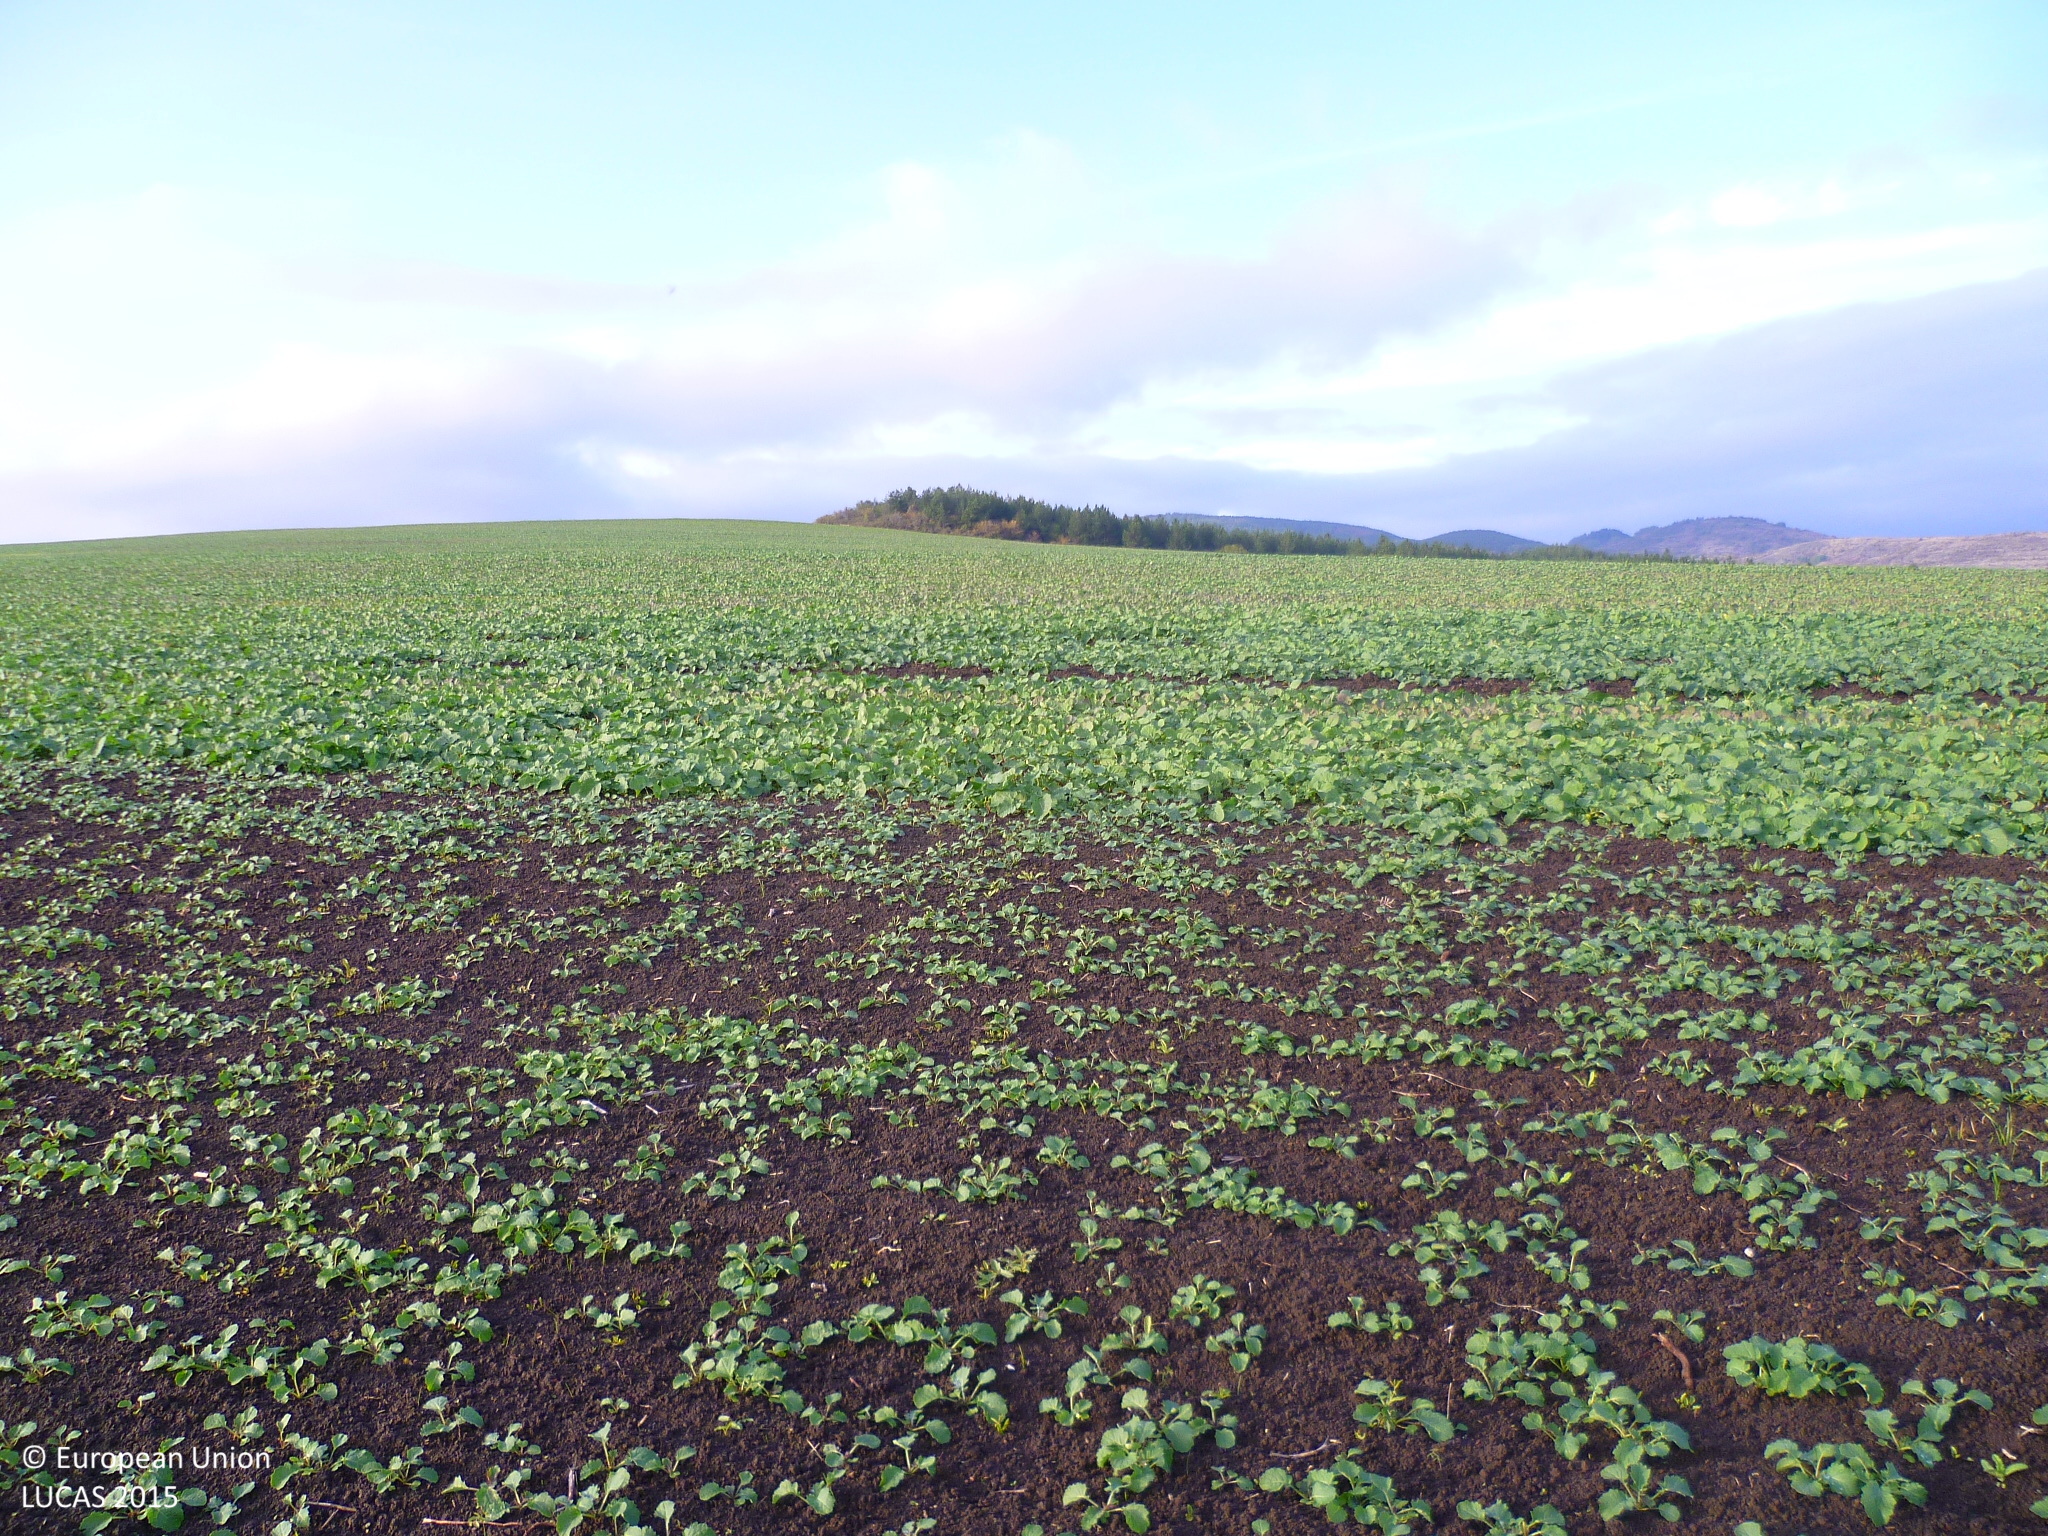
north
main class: Cropland
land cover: Rape and turnip rape
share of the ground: 50 - 75 %
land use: Agriculture (excluding fallow land and kitchen gardens)
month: October
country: BG
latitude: 42.7596
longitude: 23.0196
